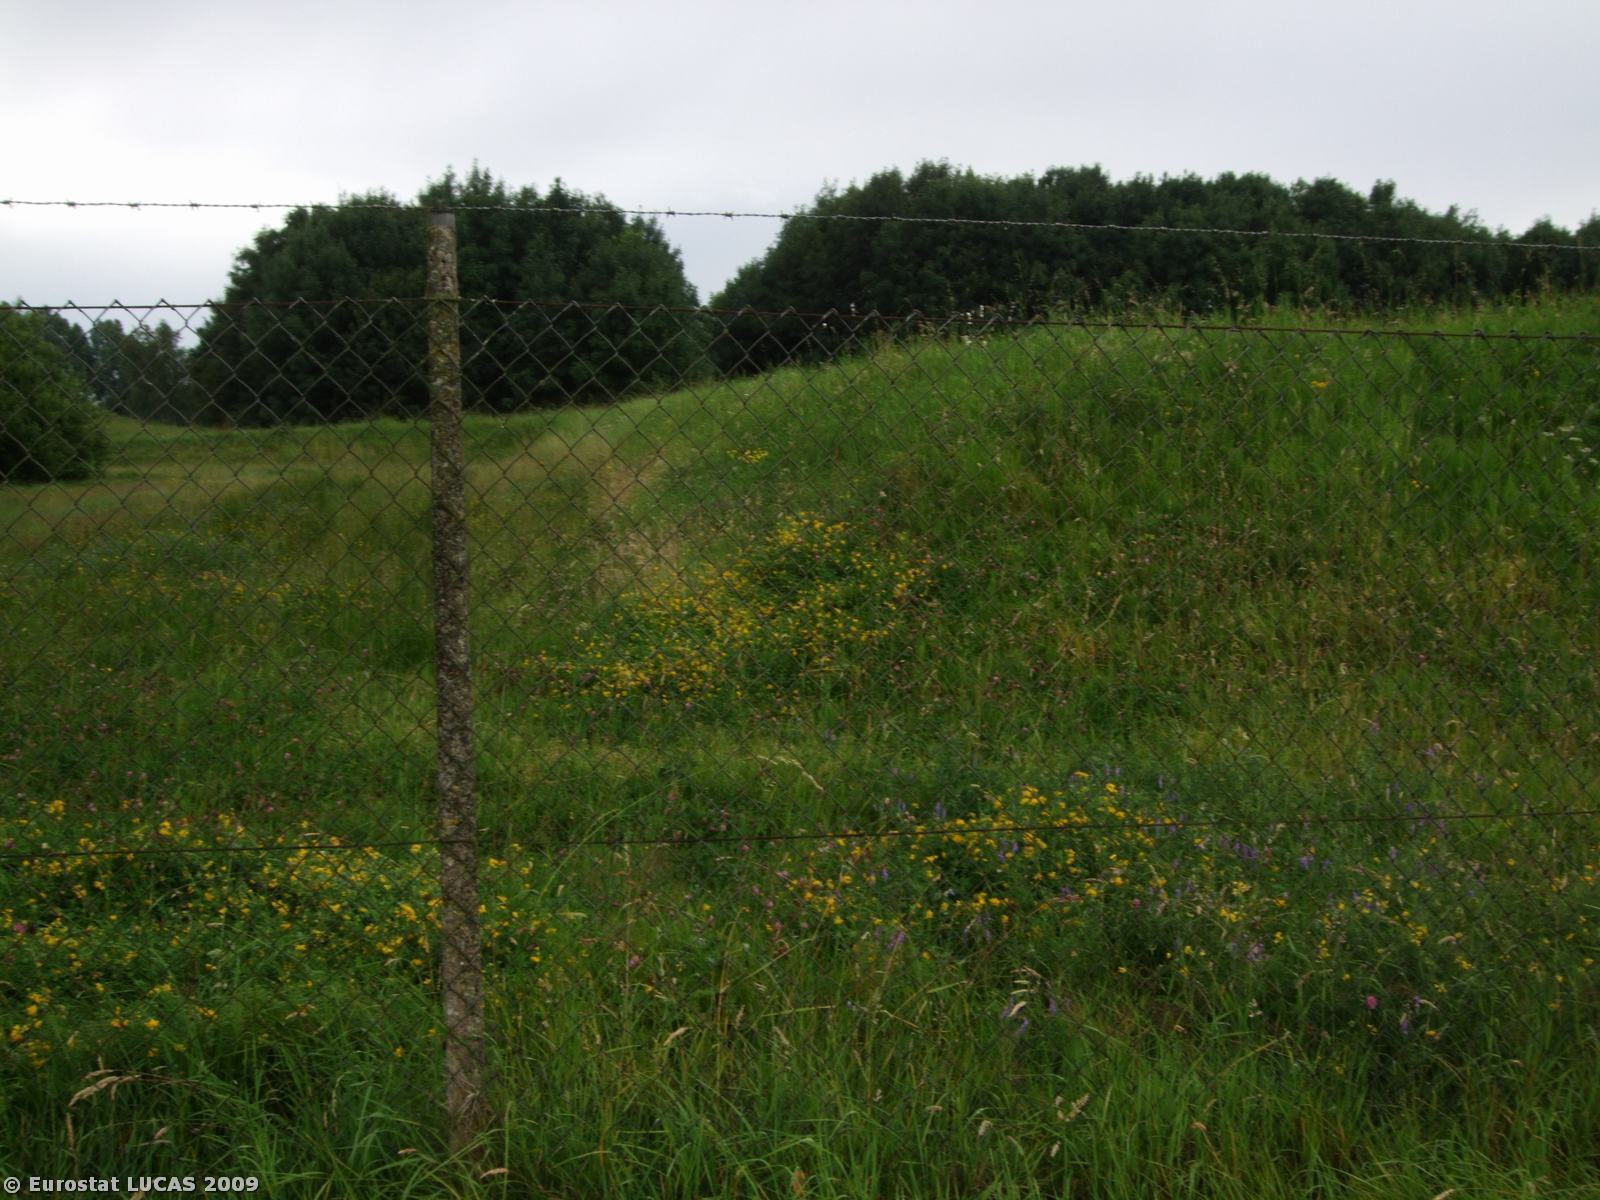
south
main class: Grassland
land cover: Grassland without tree/shrub cover
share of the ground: > 75 %
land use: Agriculture (excluding fallow land and kitchen gardens)
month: July
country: NL
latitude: 51.7844
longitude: 5.4028
